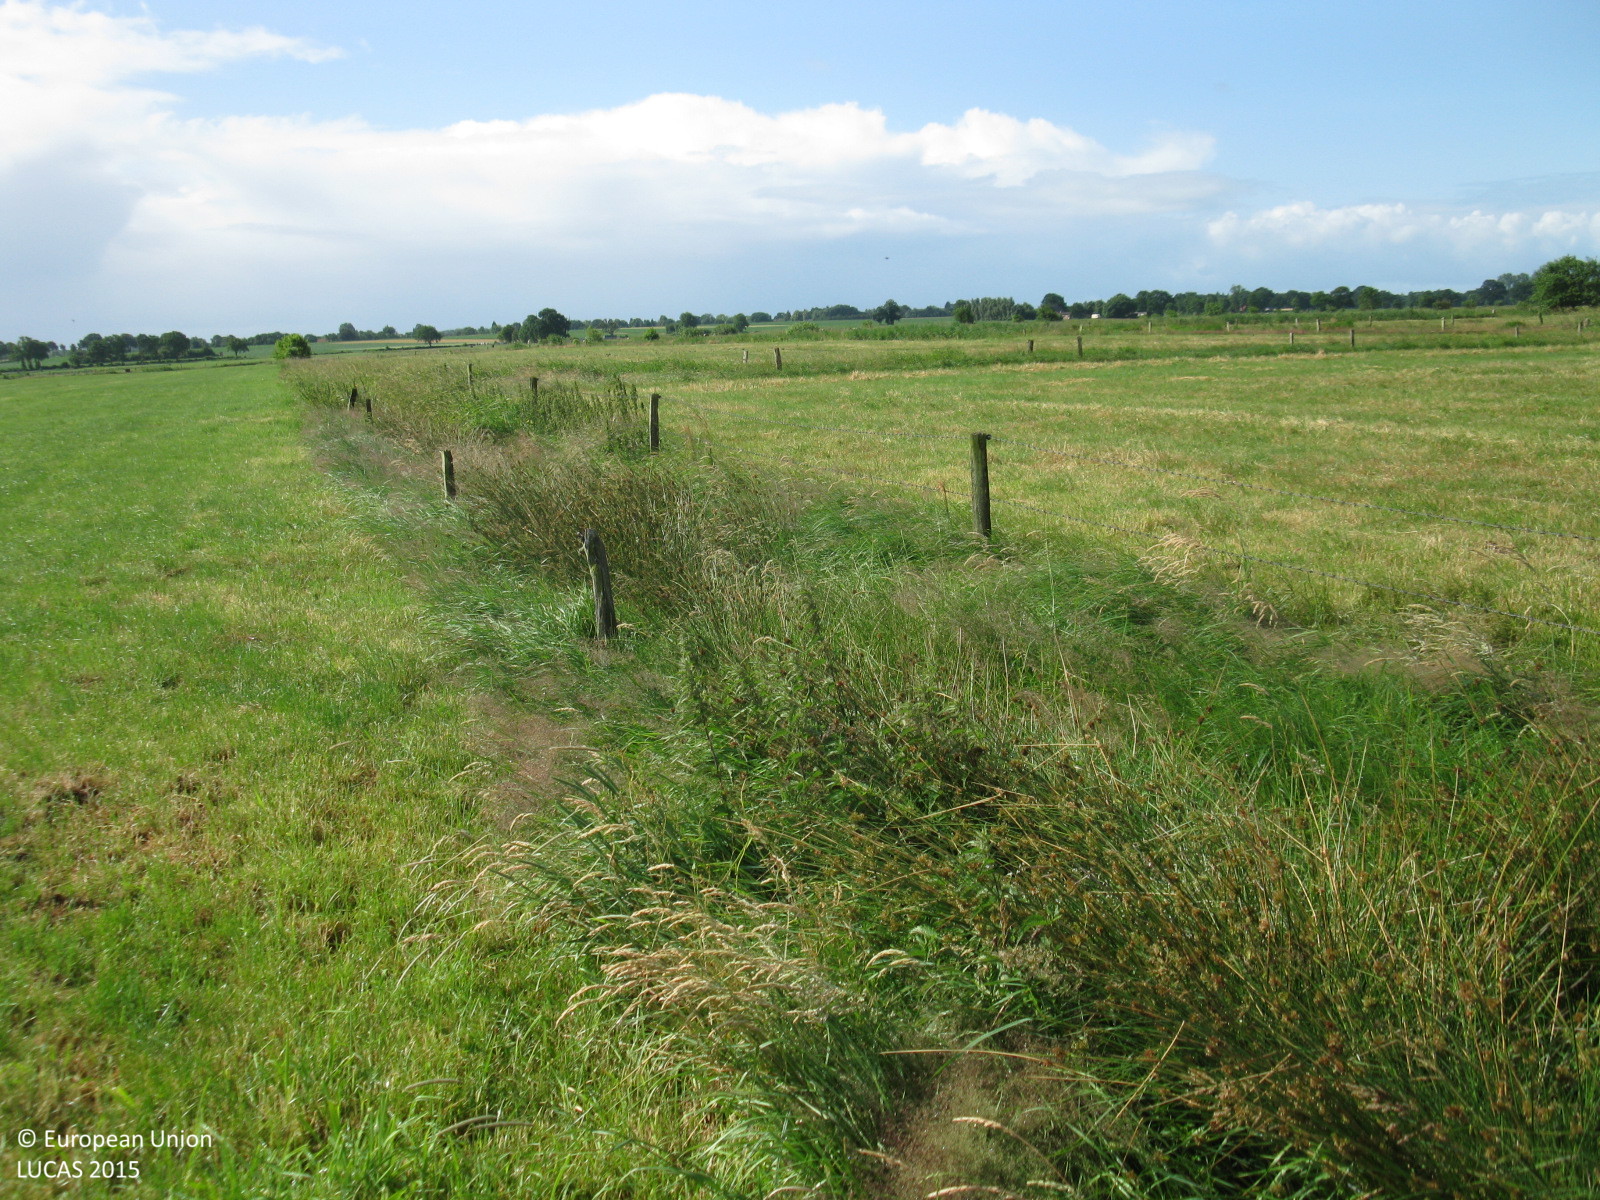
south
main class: Grassland
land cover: Grassland without tree/shrub cover
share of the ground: > 75 %
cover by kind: herbaceous plants 100 %
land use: Agriculture (excluding fallow land and kitchen gardens)
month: July
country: DE
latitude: 53.4388
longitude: 7.9684
